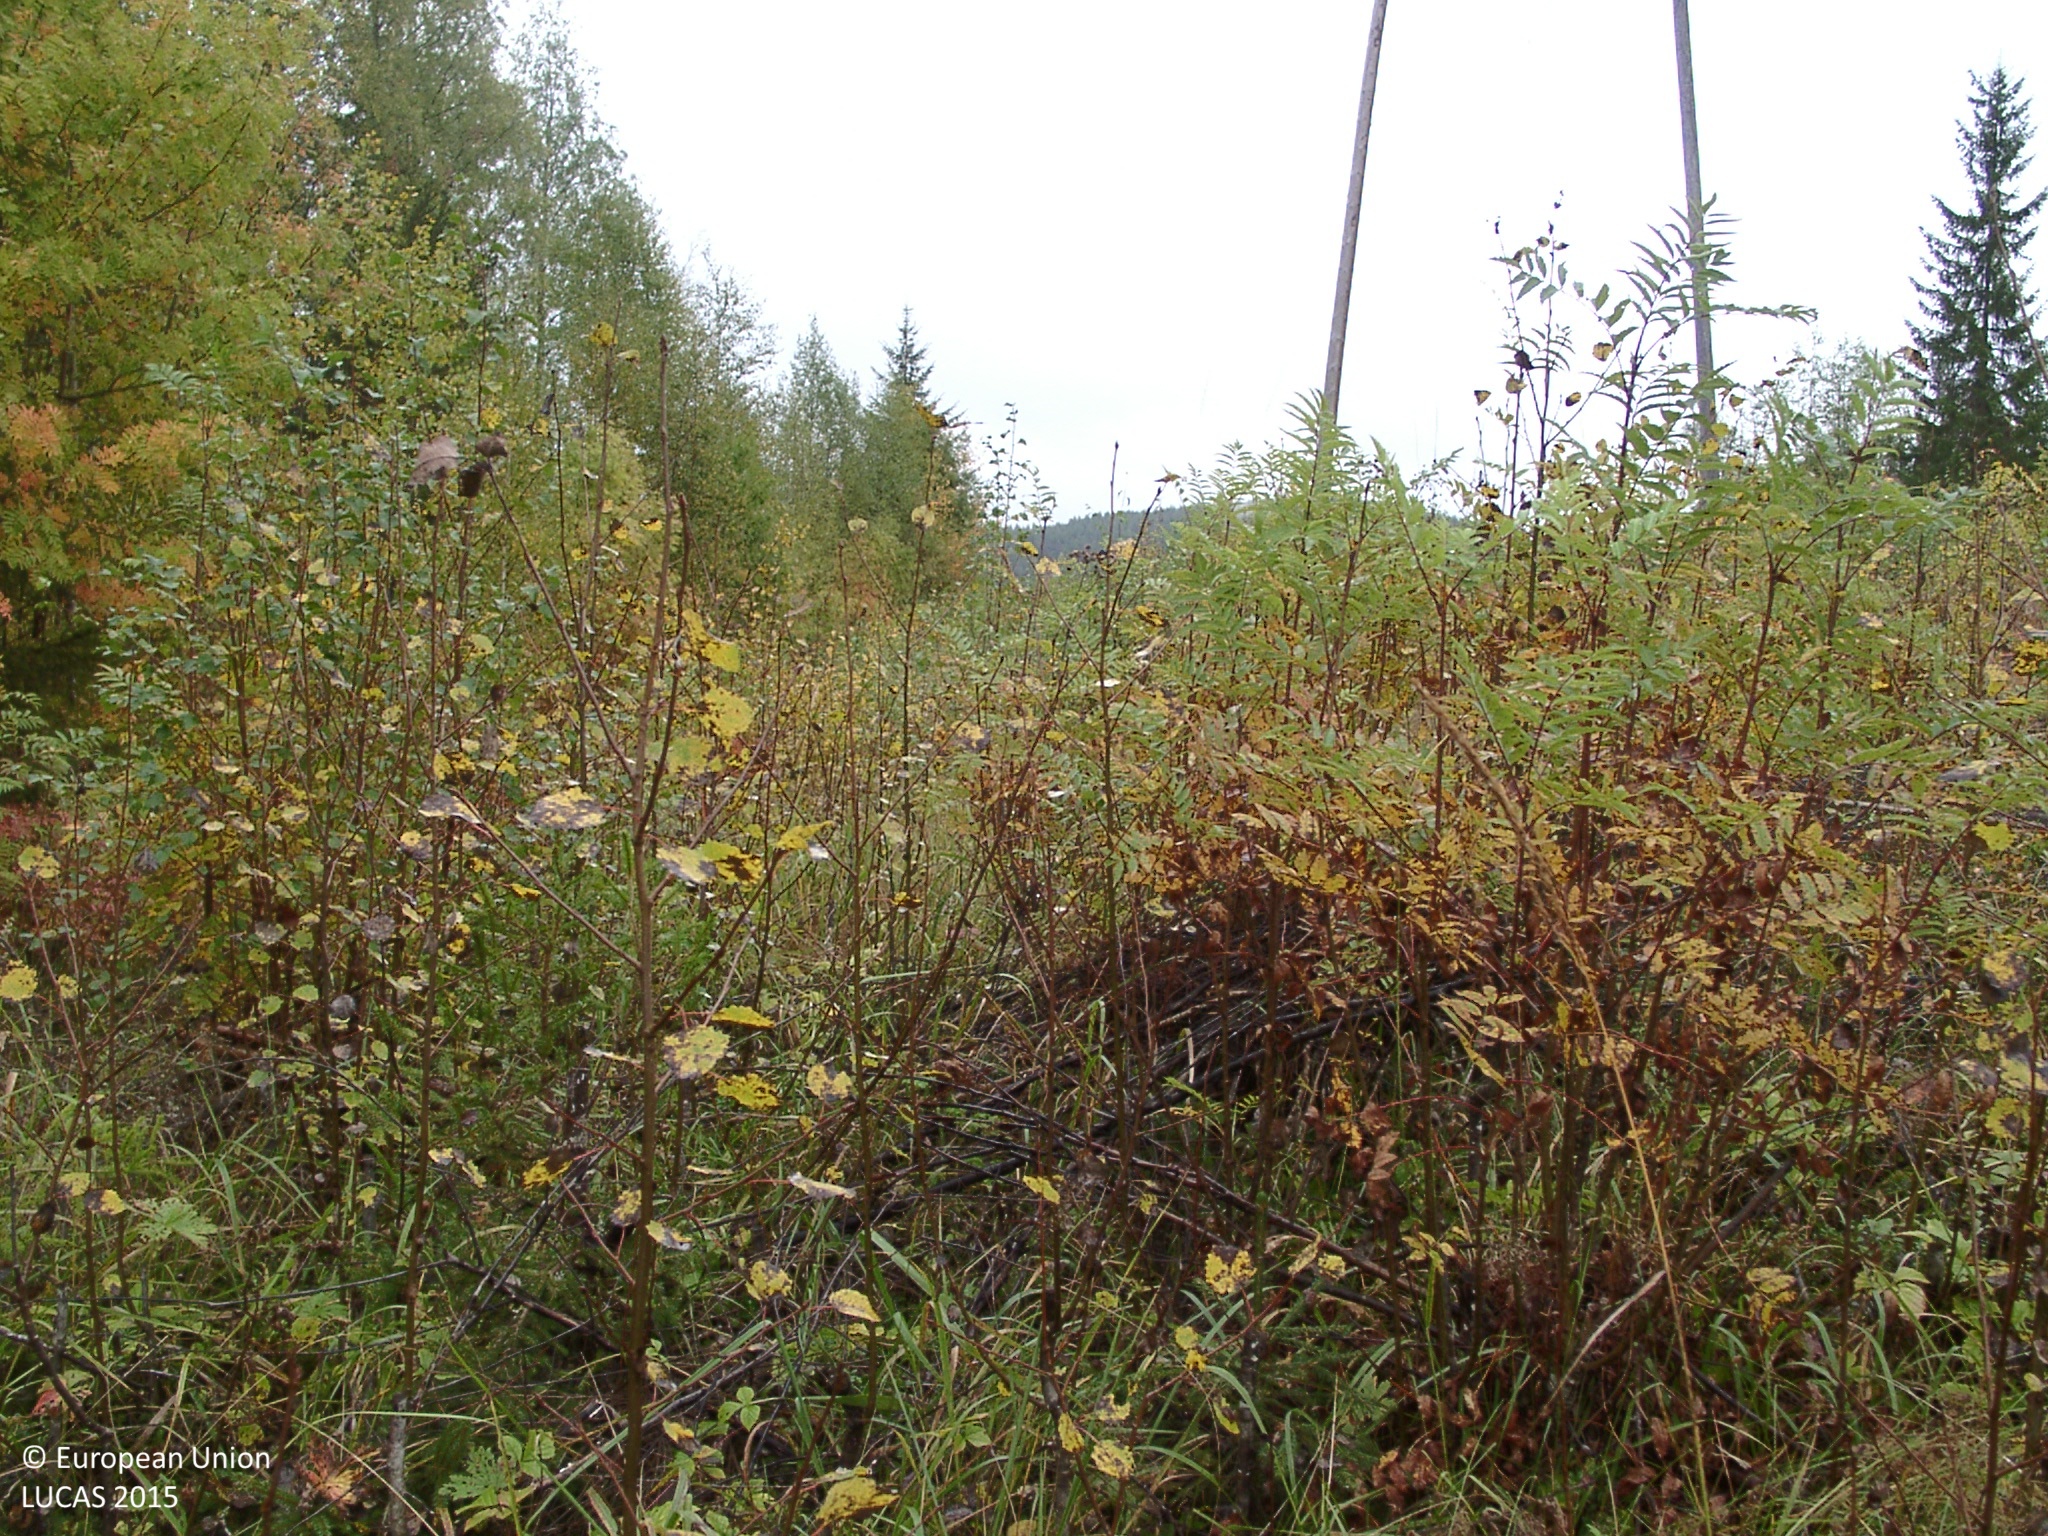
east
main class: Woodland
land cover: Broadleaved woodland
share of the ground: 25 - 50 %
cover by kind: herbaceous plants 60 %, broadleaved forest trees 35 %, shrubs 5 %
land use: Electricity, gas and thermal power distribution
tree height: < 5 m
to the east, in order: Broadleaved woodland; Barley; Electric lines; Barley; Grass margins; Electric lines; Ditches and canals; Grass margins; Tracks; Grass margins; Ditches and canals; Temporary grasslands
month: September
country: FI
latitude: 62.5861
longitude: 25.5907
